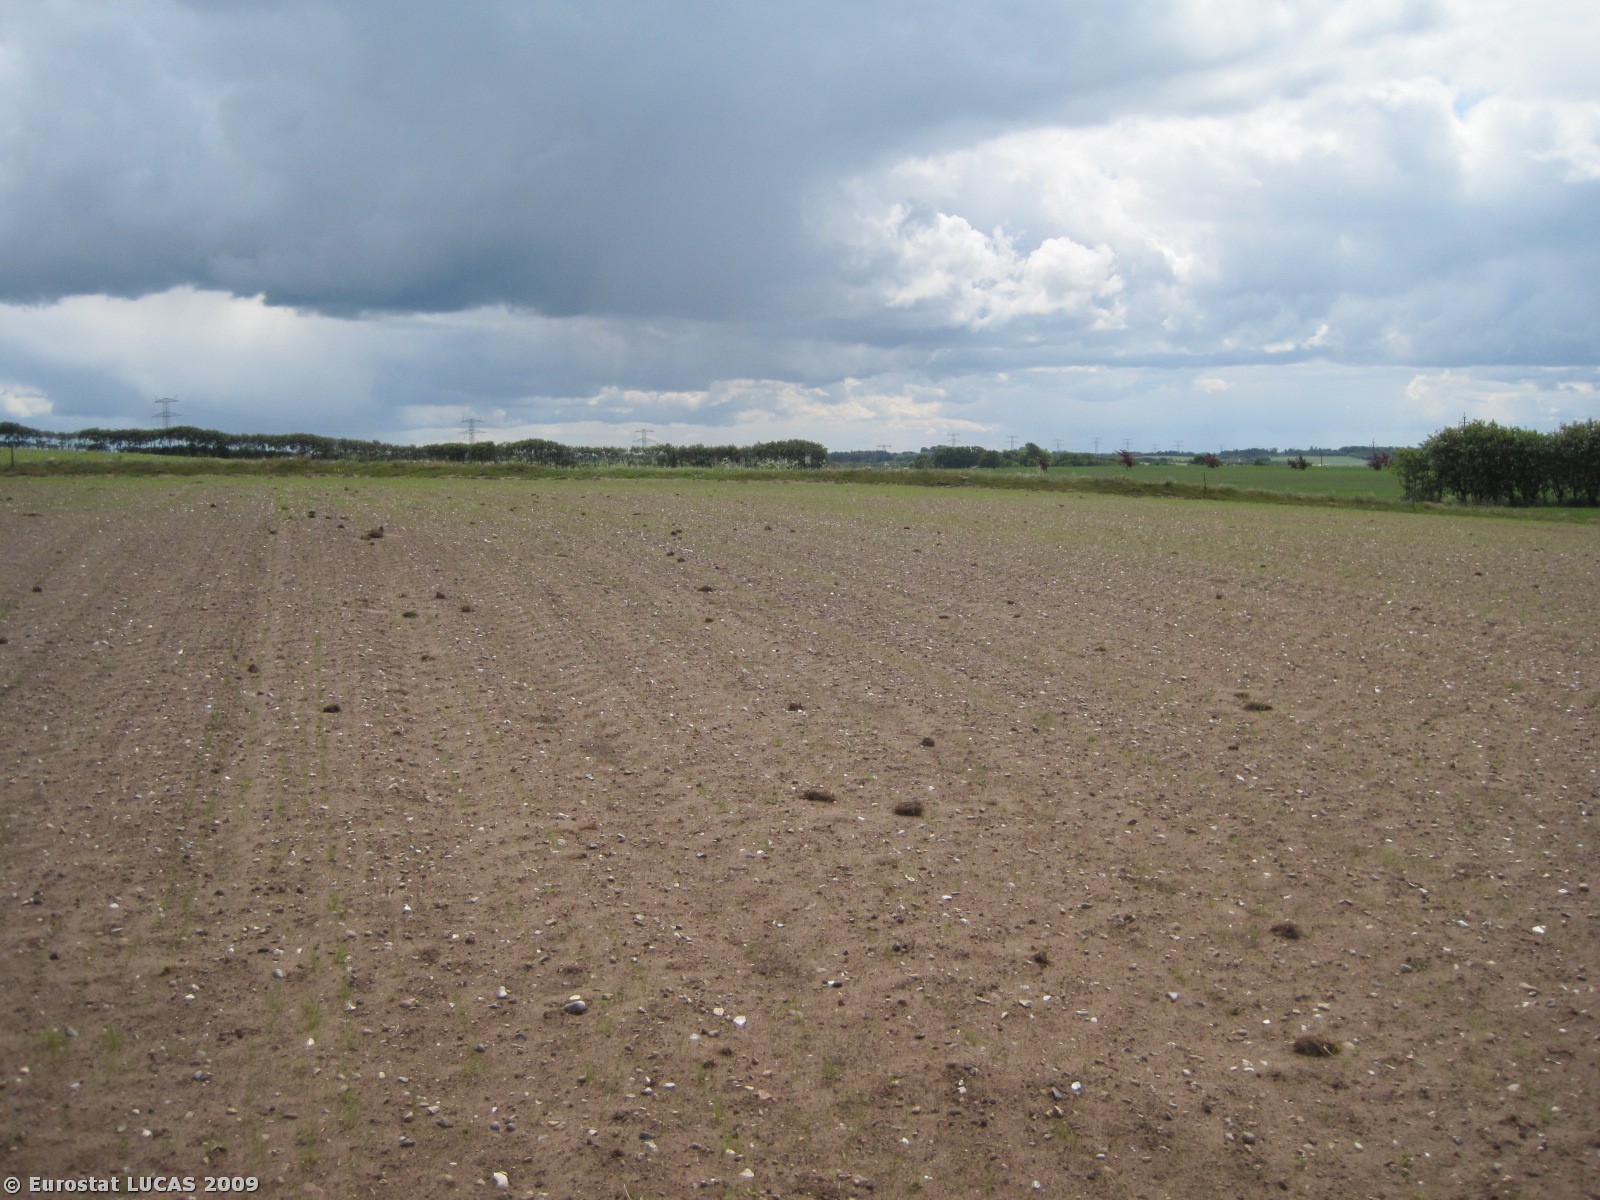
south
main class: Cropland
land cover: Common wheat
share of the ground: < 10 %
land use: Agriculture (excluding fallow land and kitchen gardens)
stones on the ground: 10 - 25 %
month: June
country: DK
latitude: 56.8885
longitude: 9.6886
